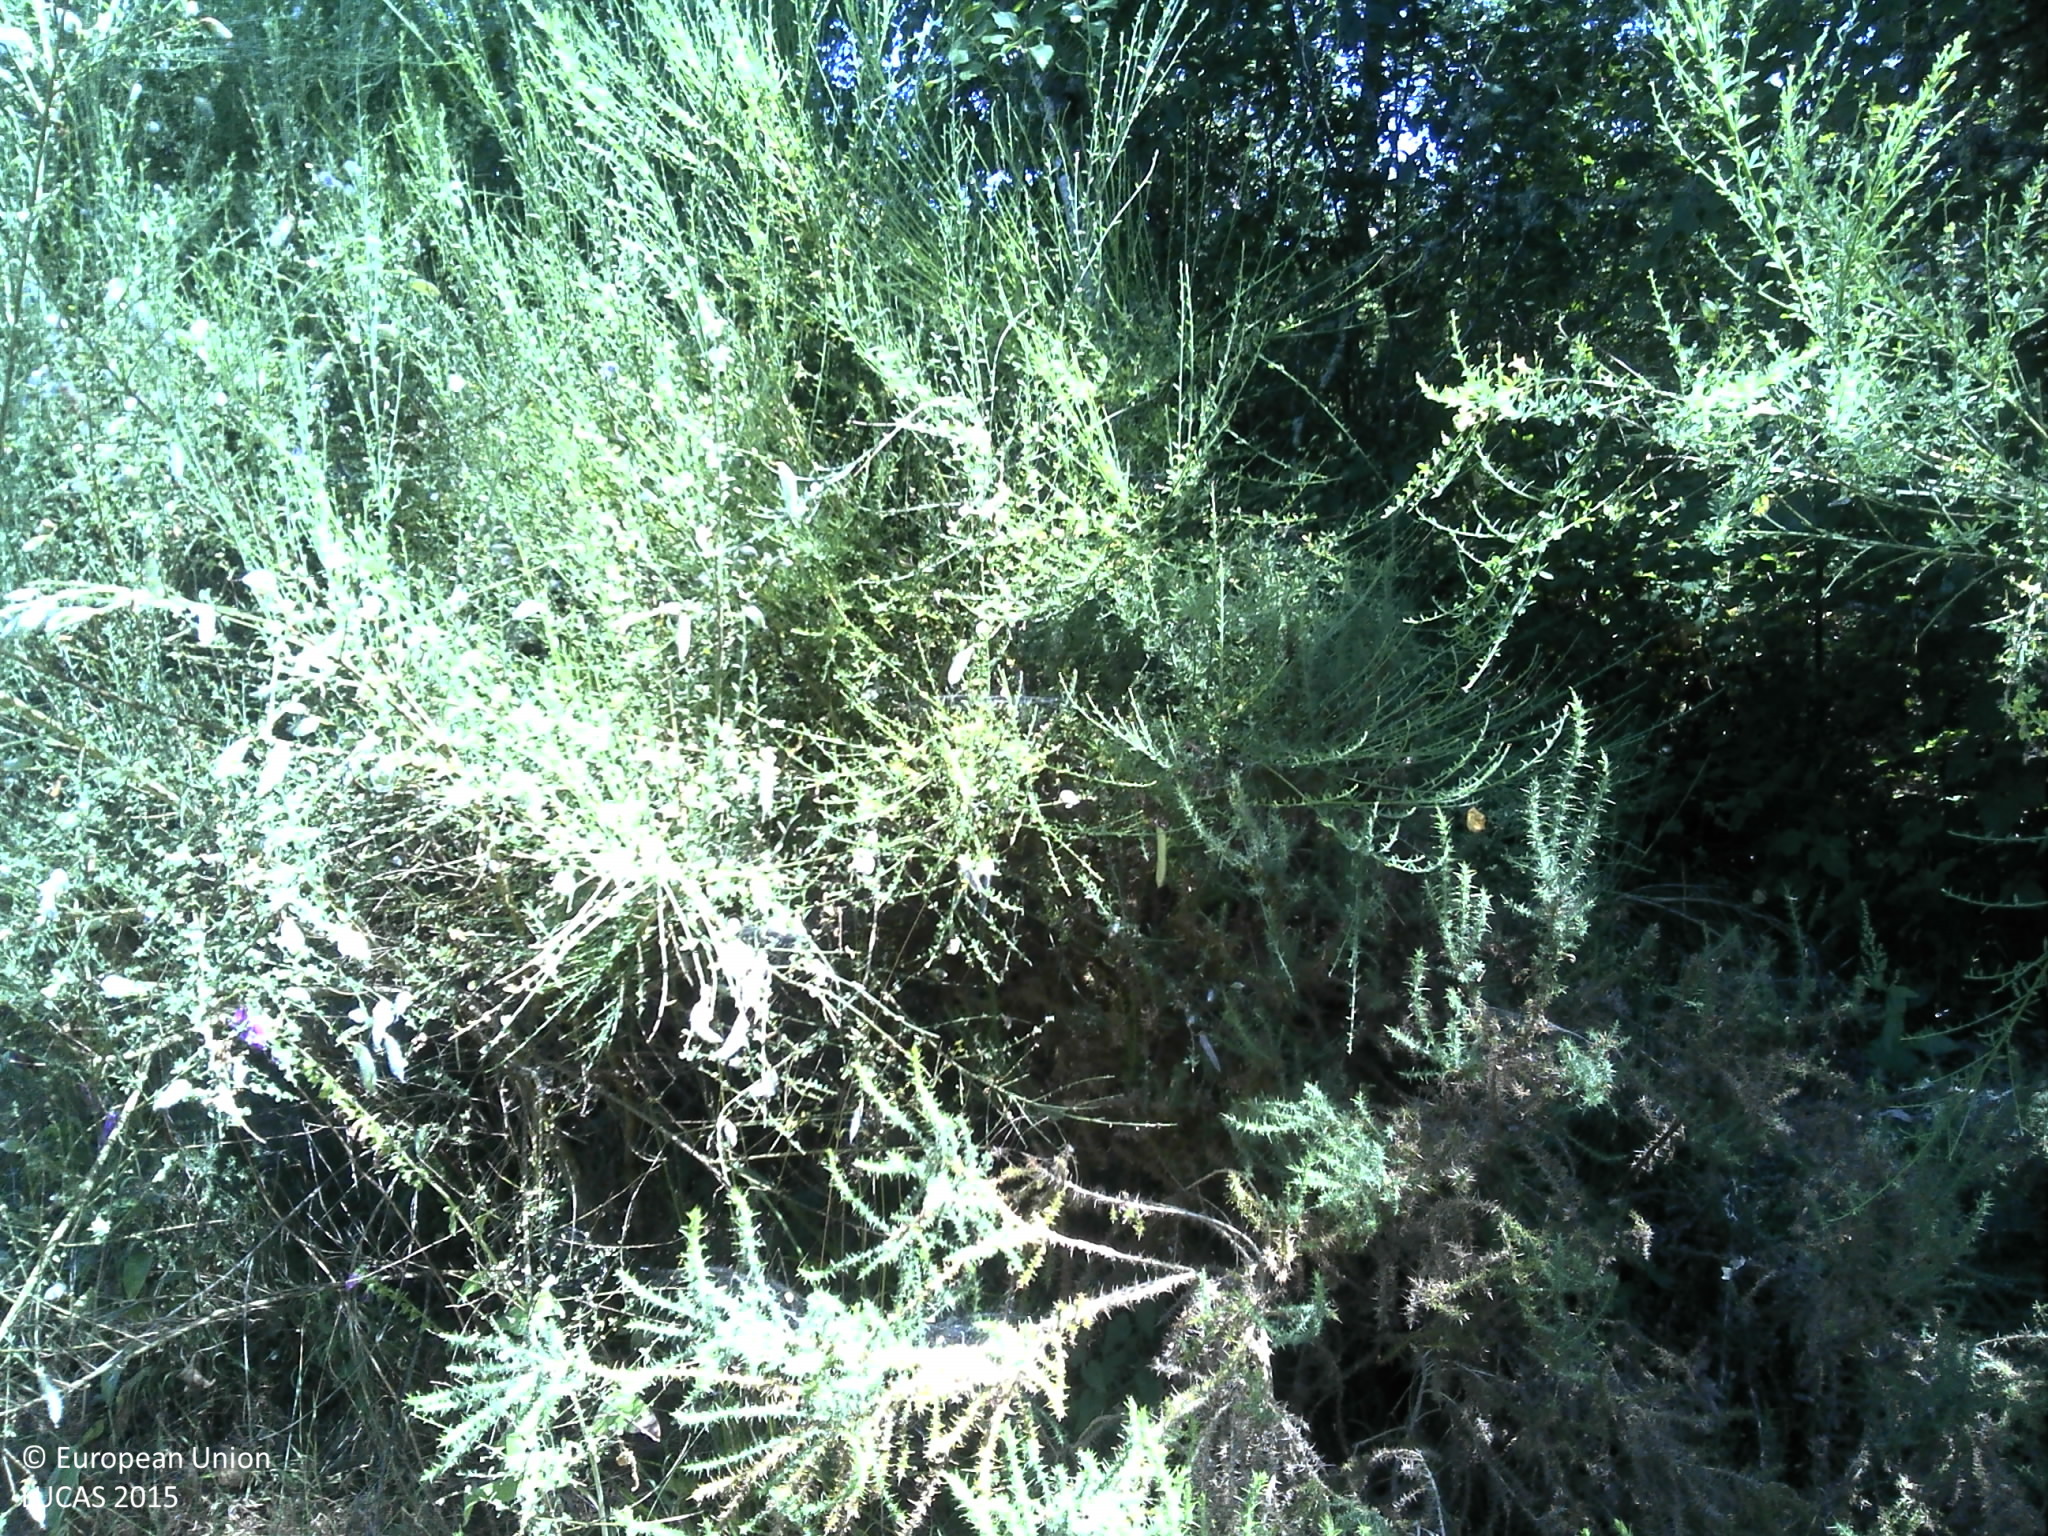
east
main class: Grassland
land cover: Grassland with sparse tree/shrub cover
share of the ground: > 75 %
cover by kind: herbaceous plants 85 %, unconsolidated bare surface 10 %, broadleaved forest trees 5 %
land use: Agriculture (excluding fallow land and kitchen gardens)
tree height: > 5 m
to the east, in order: Grassland with sparse tree/shrub cover; Broadleaved woodland; Shrubland with sparse tree cover; Broadleaved woodland; Shrubland without tree cover; Paved roads, cycling and walking lanes; Broadleaved woodland; Shrubland without tree cover
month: July
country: PT
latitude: 41.8214
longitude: -7.5791
